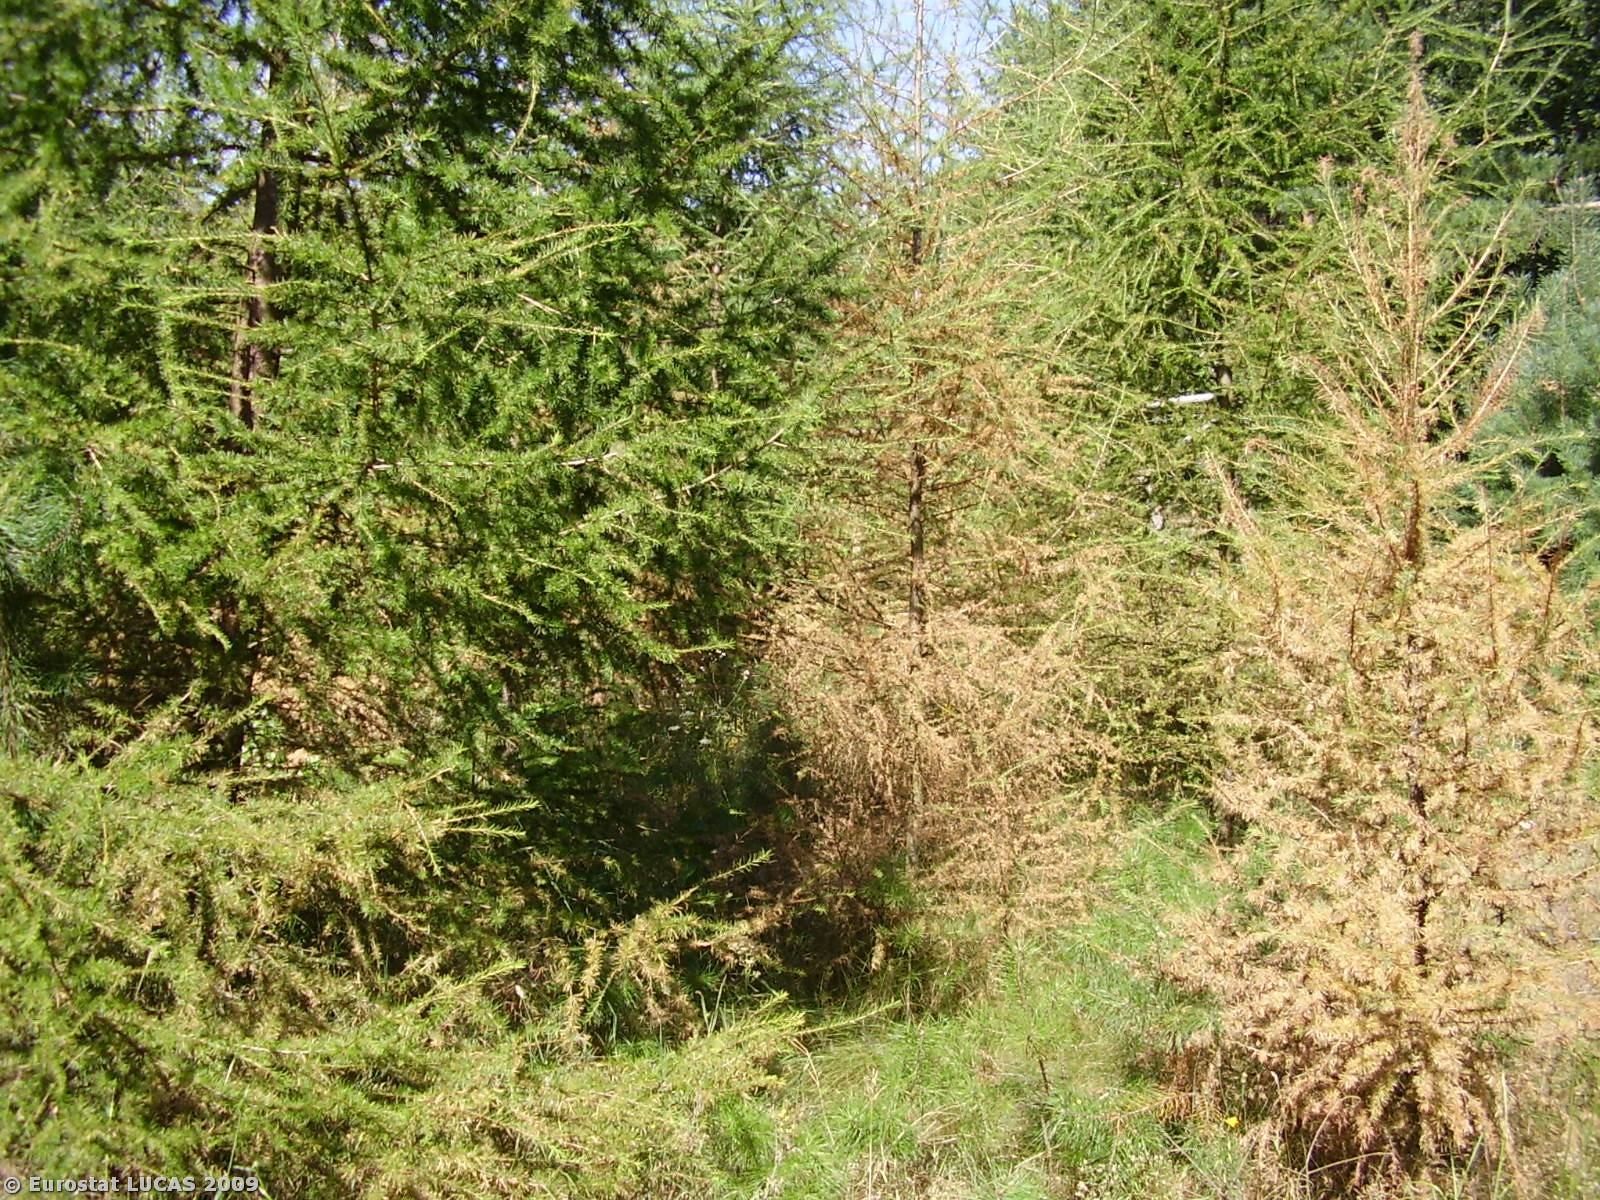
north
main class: Woodland
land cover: Coniferous woodland
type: hemiboreal forest and nemoral coniferous forest and mixed broadleaved-coniferous forest
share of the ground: > 75 %
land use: Forestry
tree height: > 5 m
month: August
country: PL
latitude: 51.3346
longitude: 16.7983
